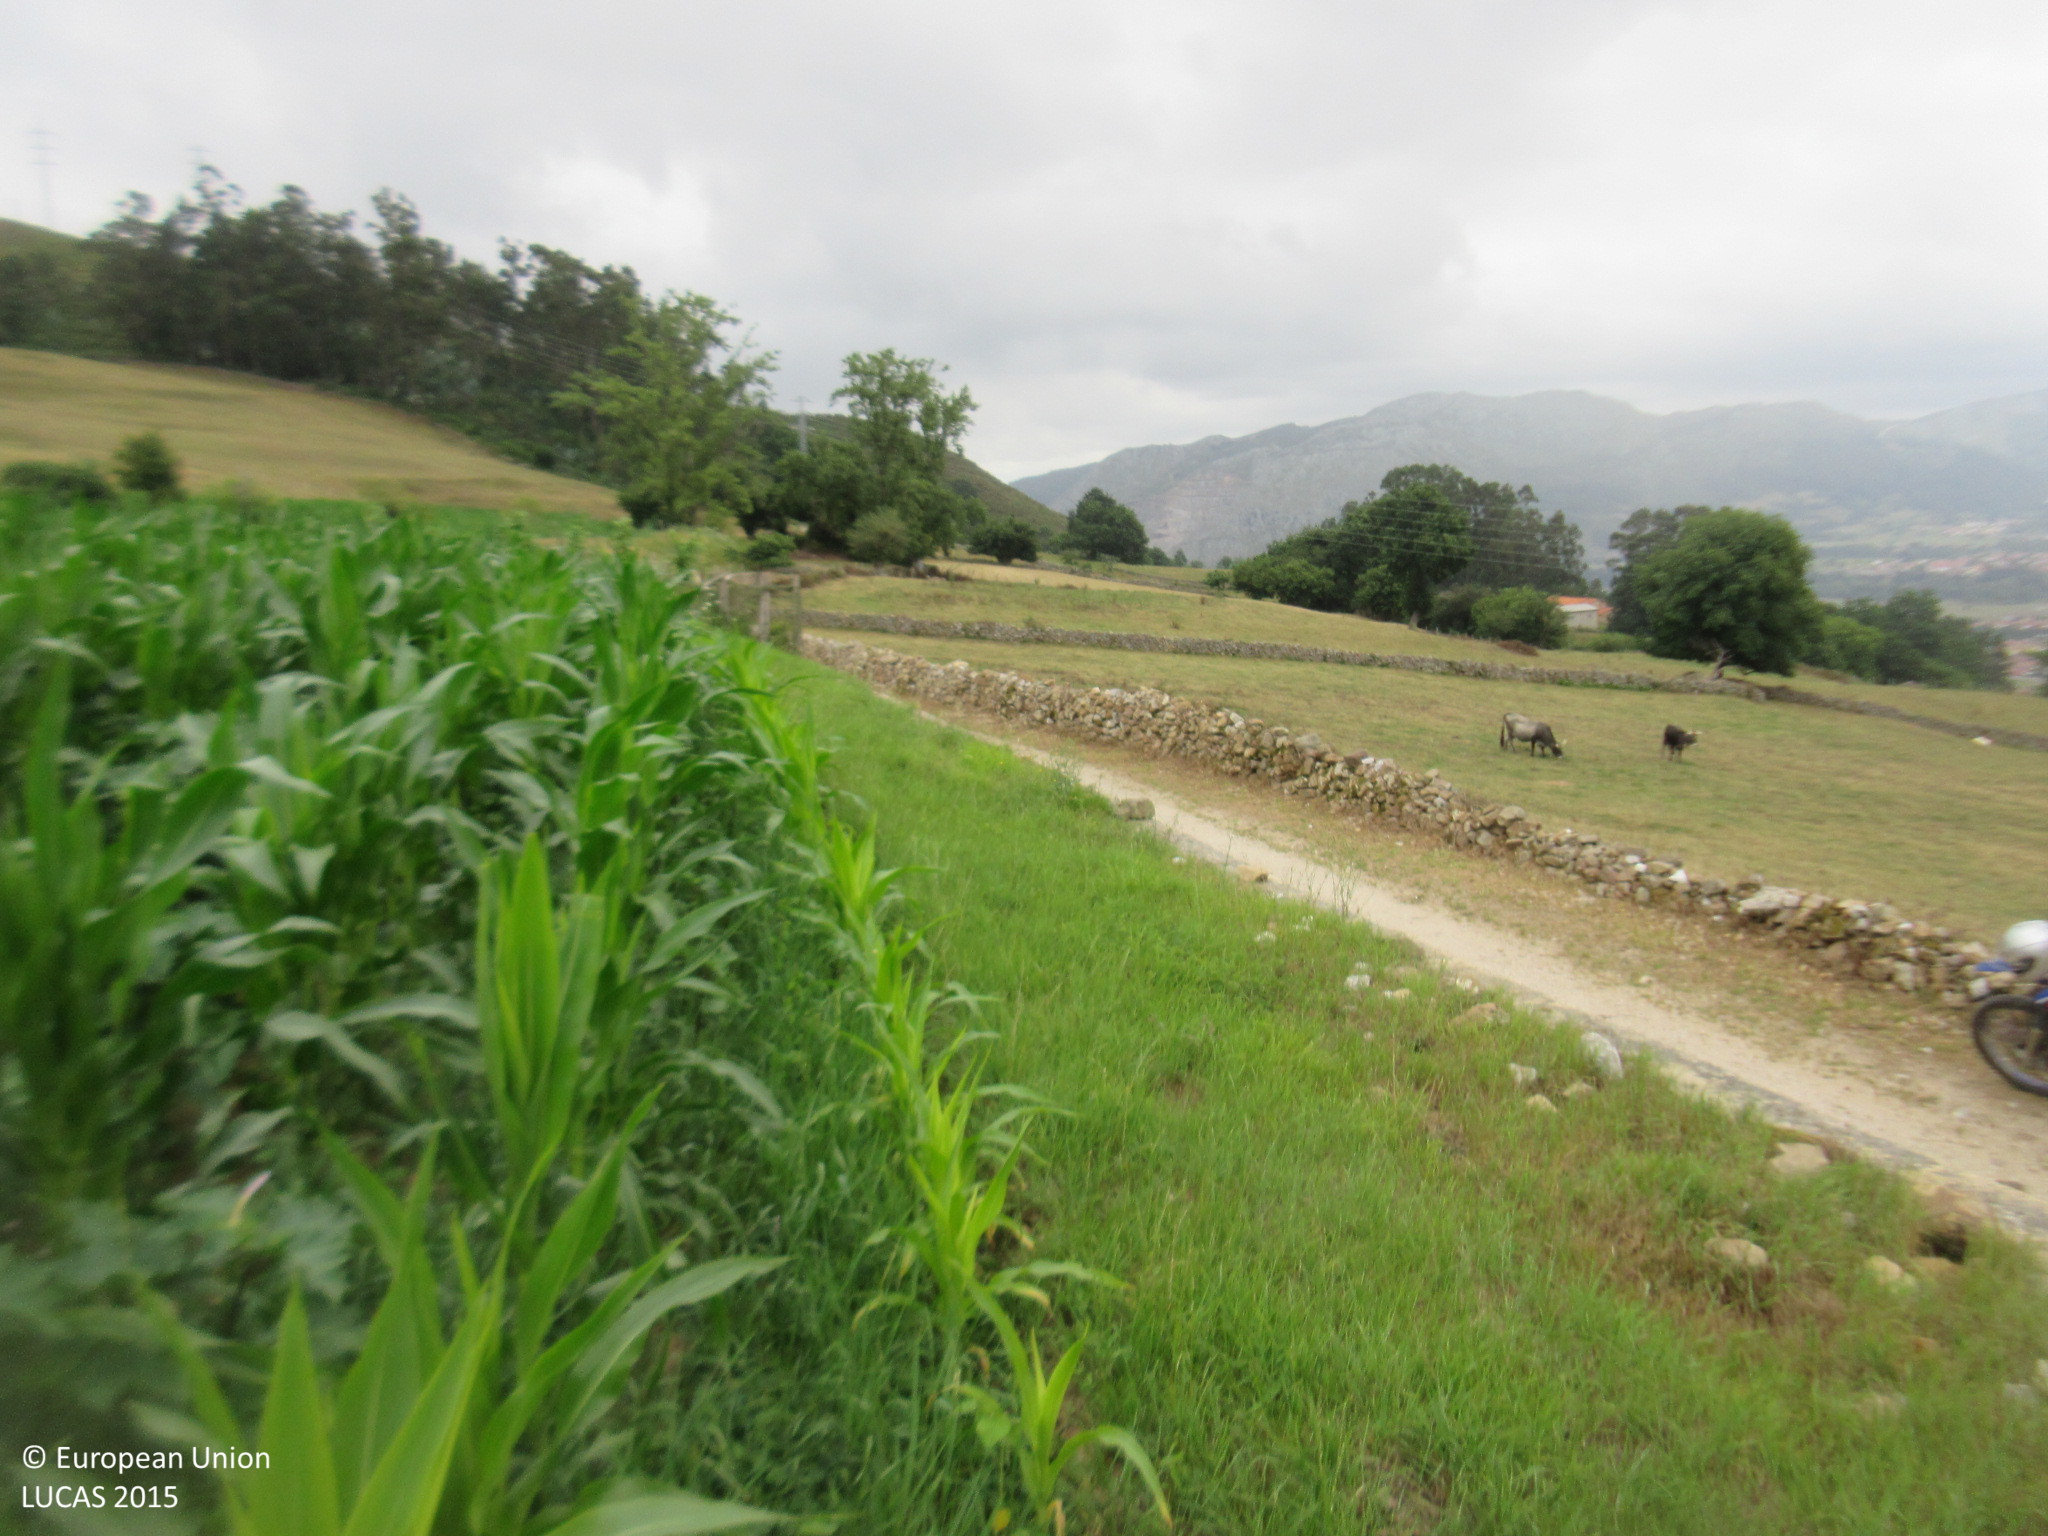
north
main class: Cropland
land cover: Maize
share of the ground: > 75 %
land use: Agriculture (excluding fallow land and kitchen gardens)
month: July
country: ES
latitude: 43.2566
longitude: -4.0821
